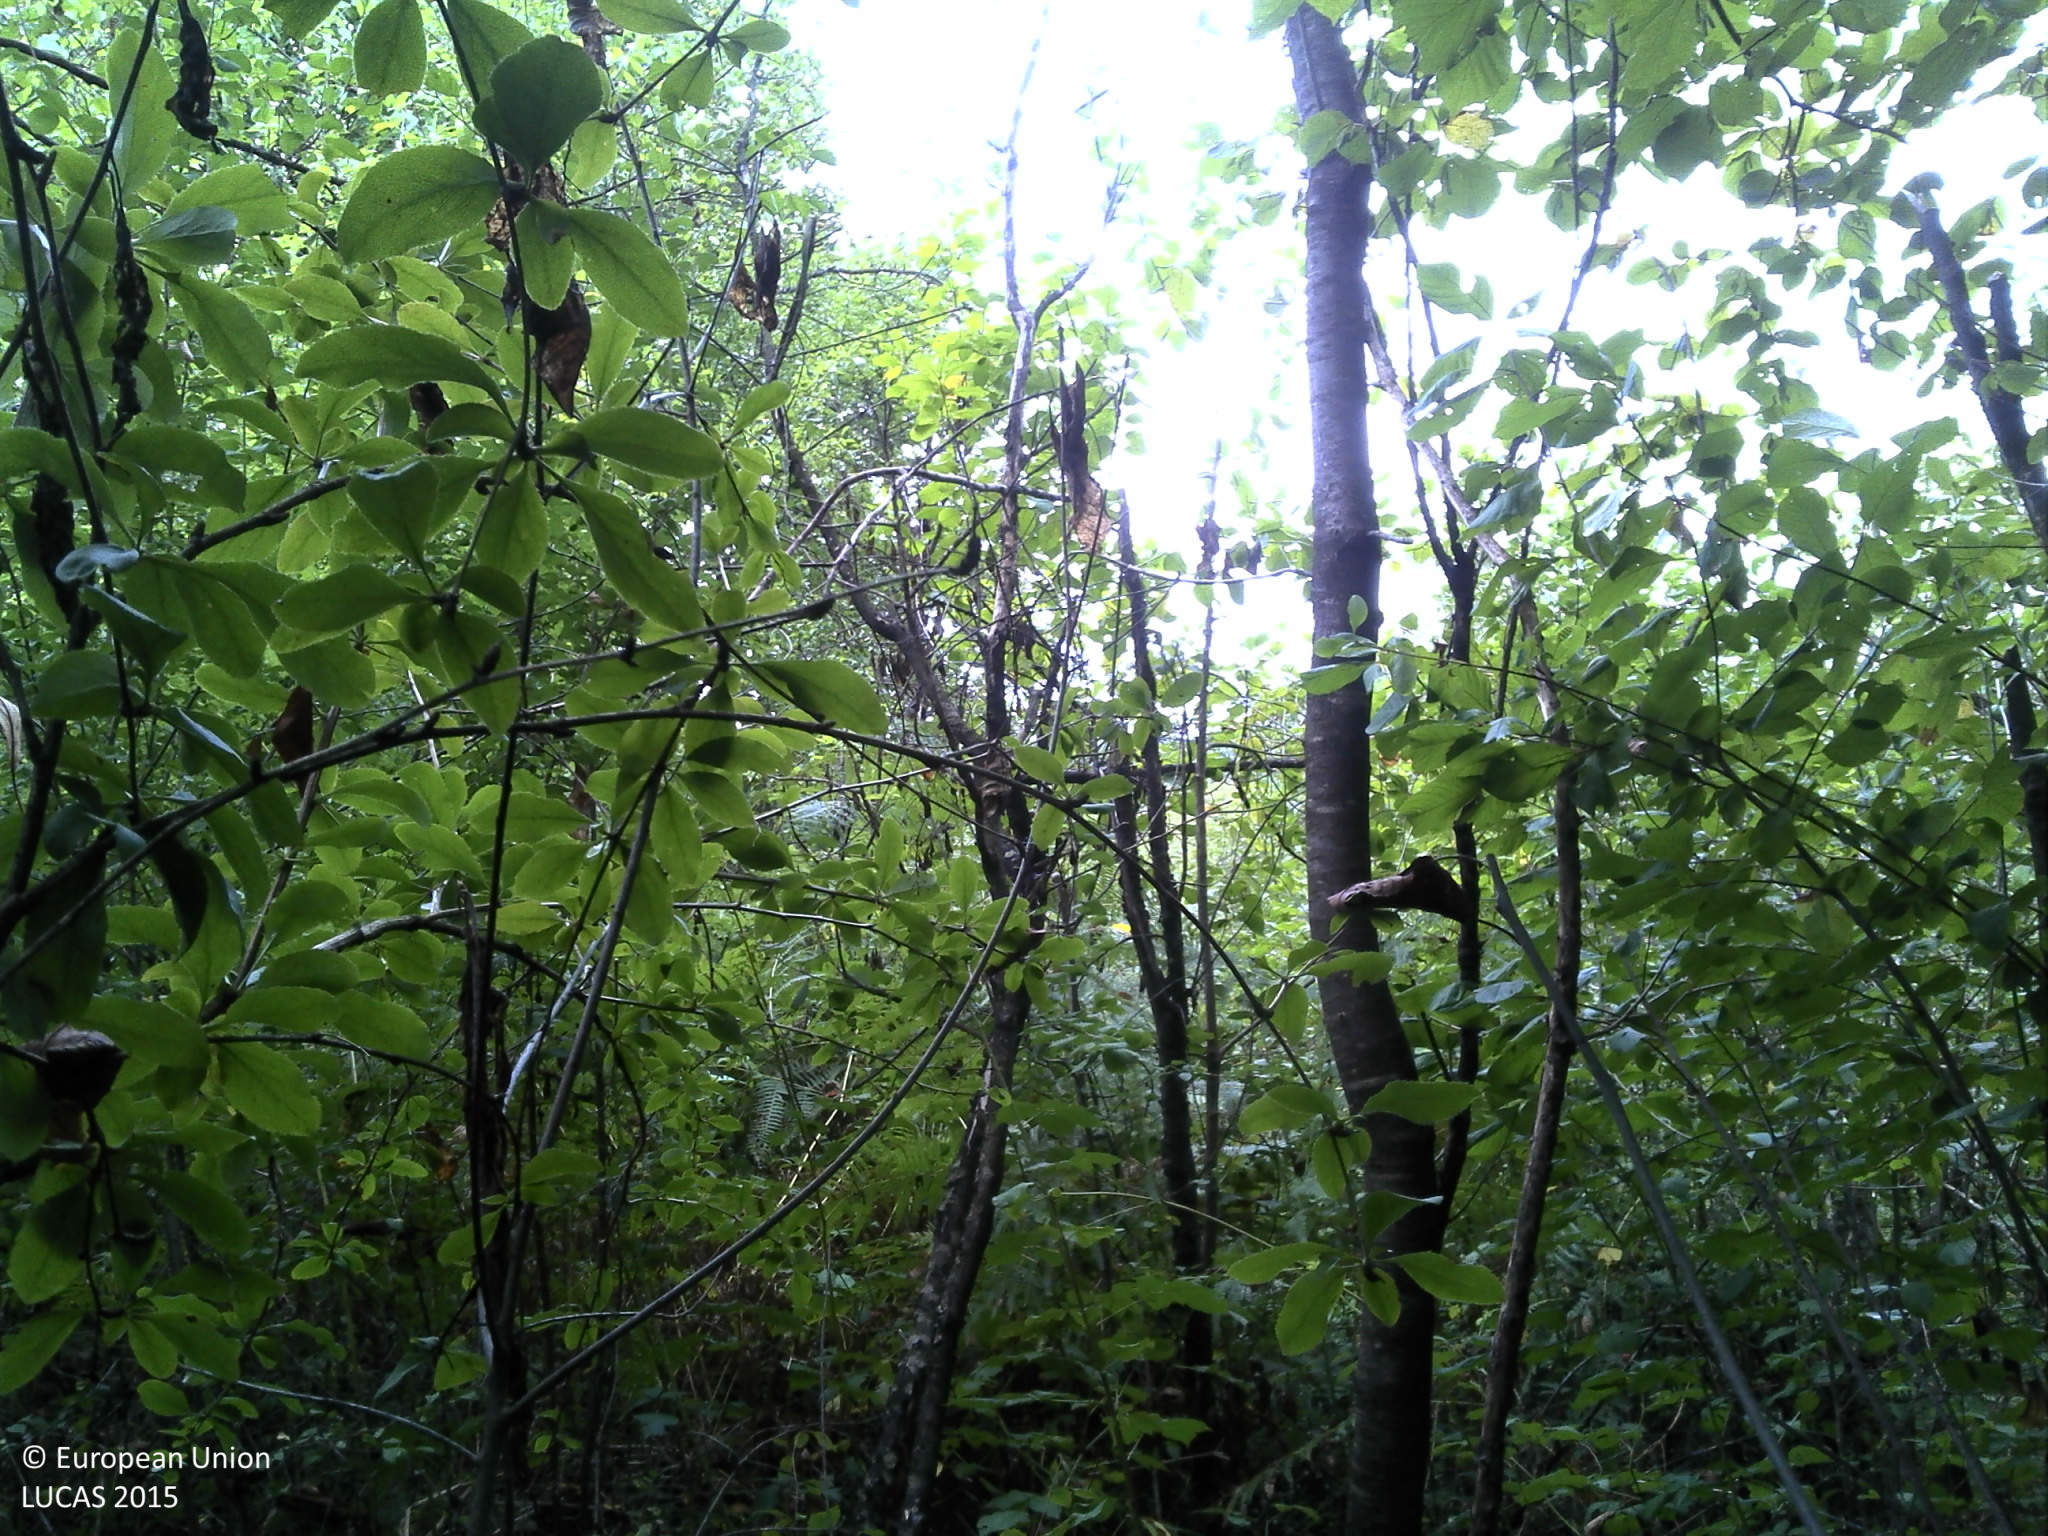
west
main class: Woodland
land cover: Broadleaved woodland
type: beech forest
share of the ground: > 75 %
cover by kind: broadleaved forest trees 100 %
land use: Forestry
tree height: > 5 m
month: August
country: HR
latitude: 45.3863
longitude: 15.7053
